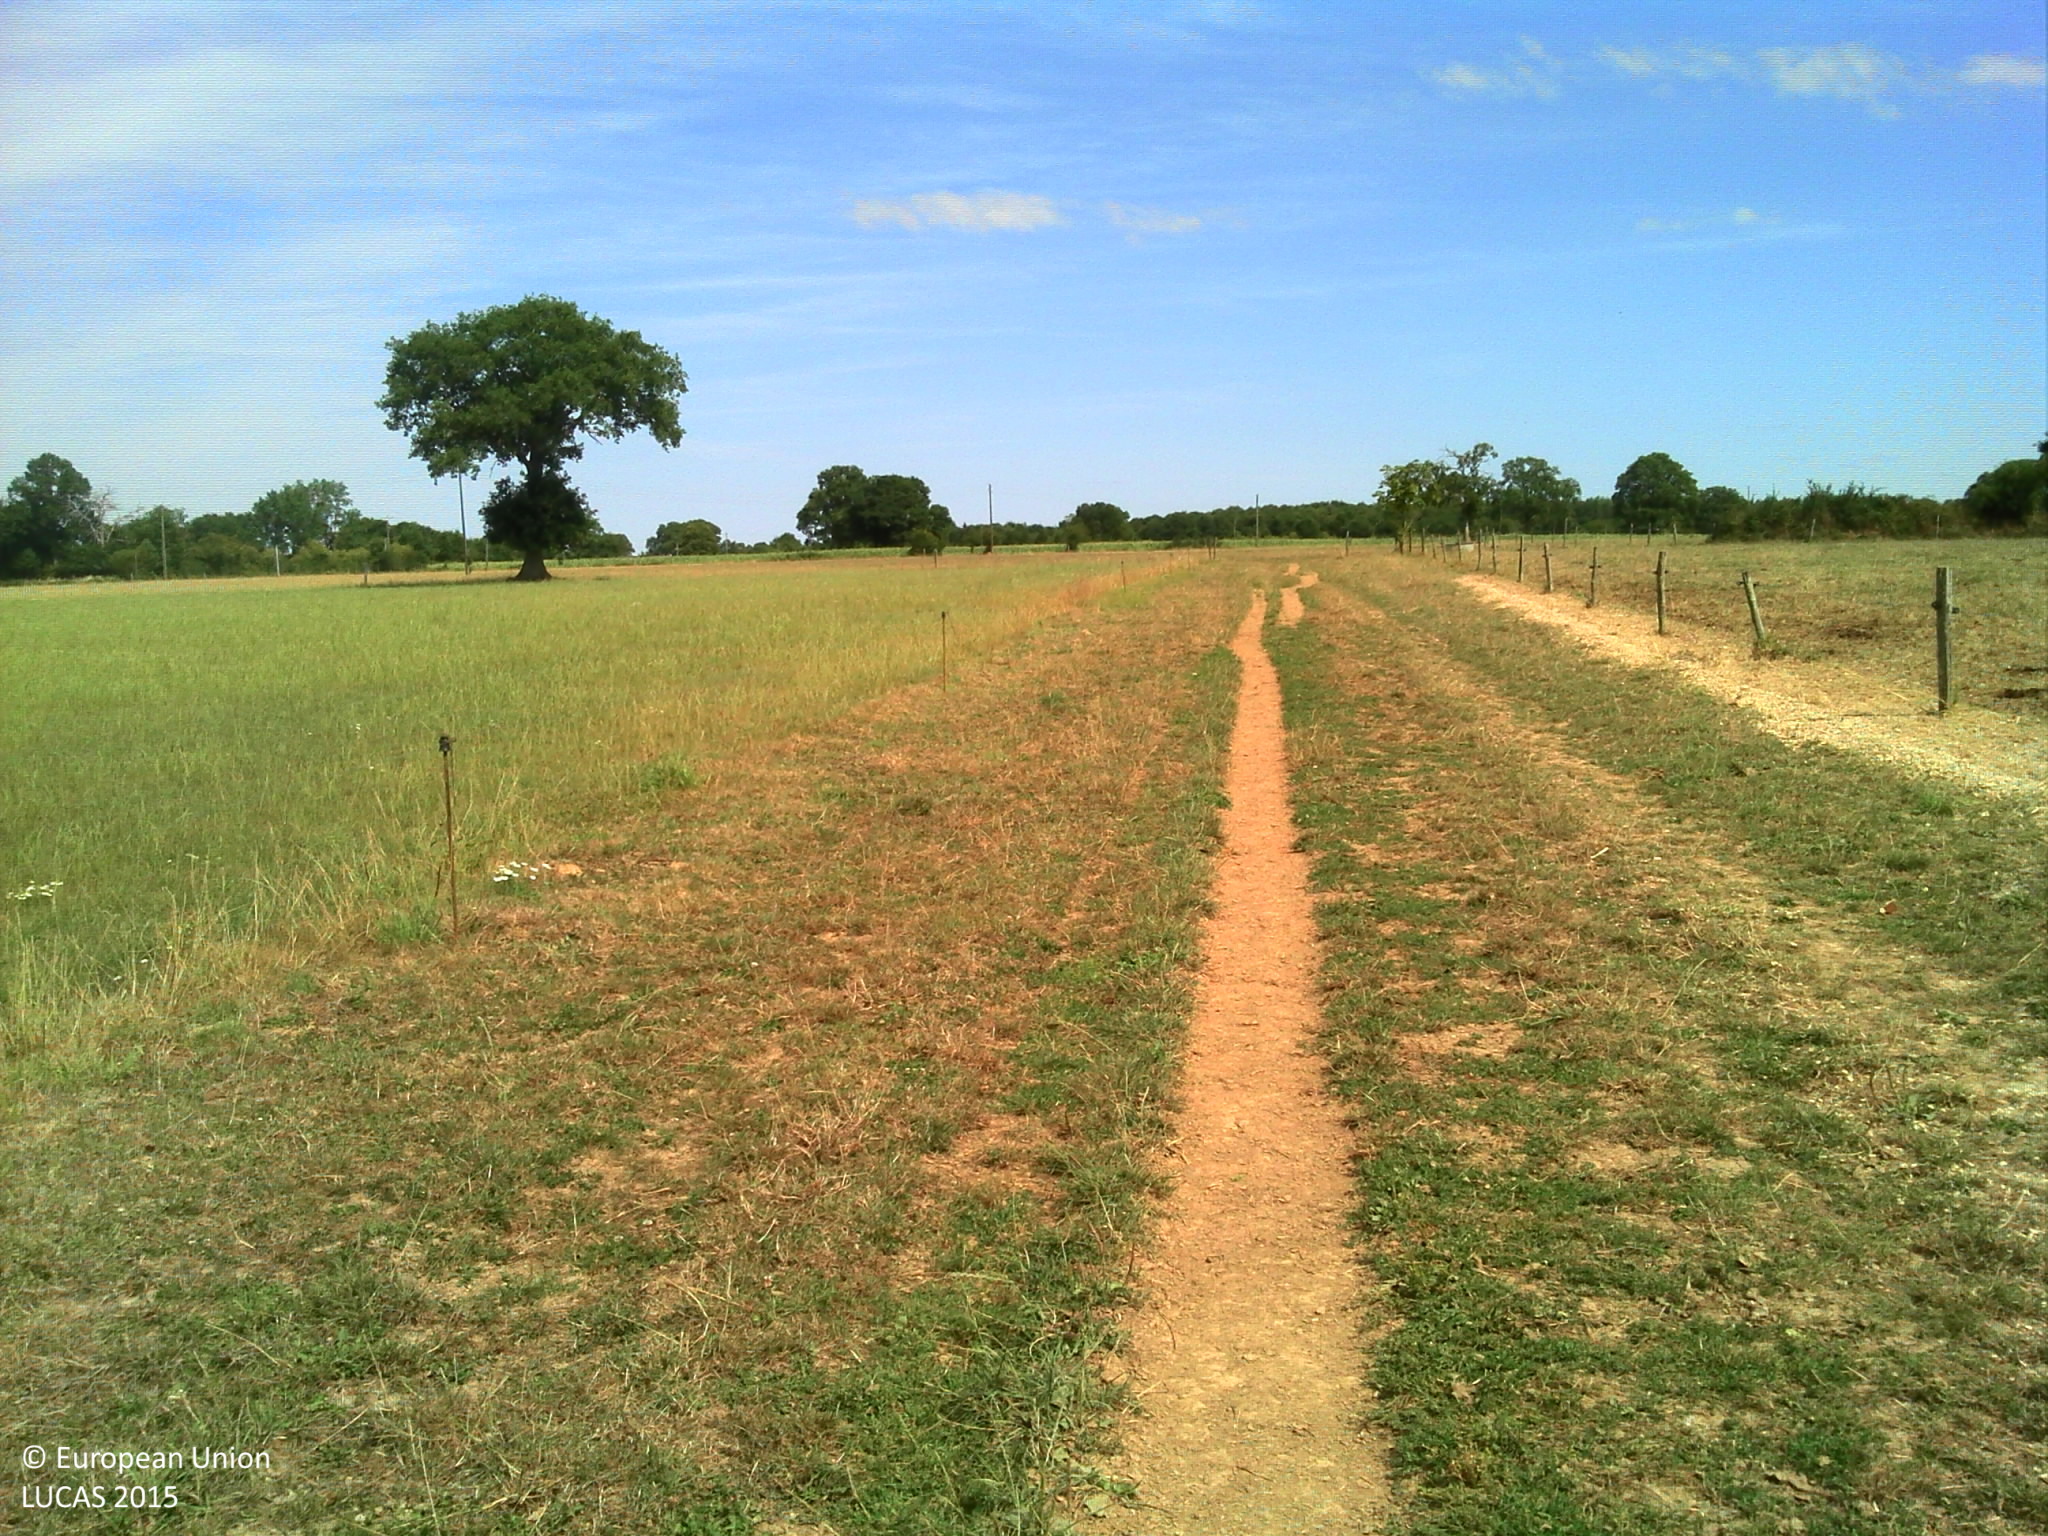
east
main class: Grassland
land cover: Grassland without tree/shrub cover
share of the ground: > 75 %
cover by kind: herbaceous plants 100 %
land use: Agriculture (excluding fallow land and kitchen gardens)
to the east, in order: Grassland without tree/shrub cover; Fences; Grassland without tree/shrub cover; Fences; Common wheat
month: August
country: FR
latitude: 47.8916
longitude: -1.1546
